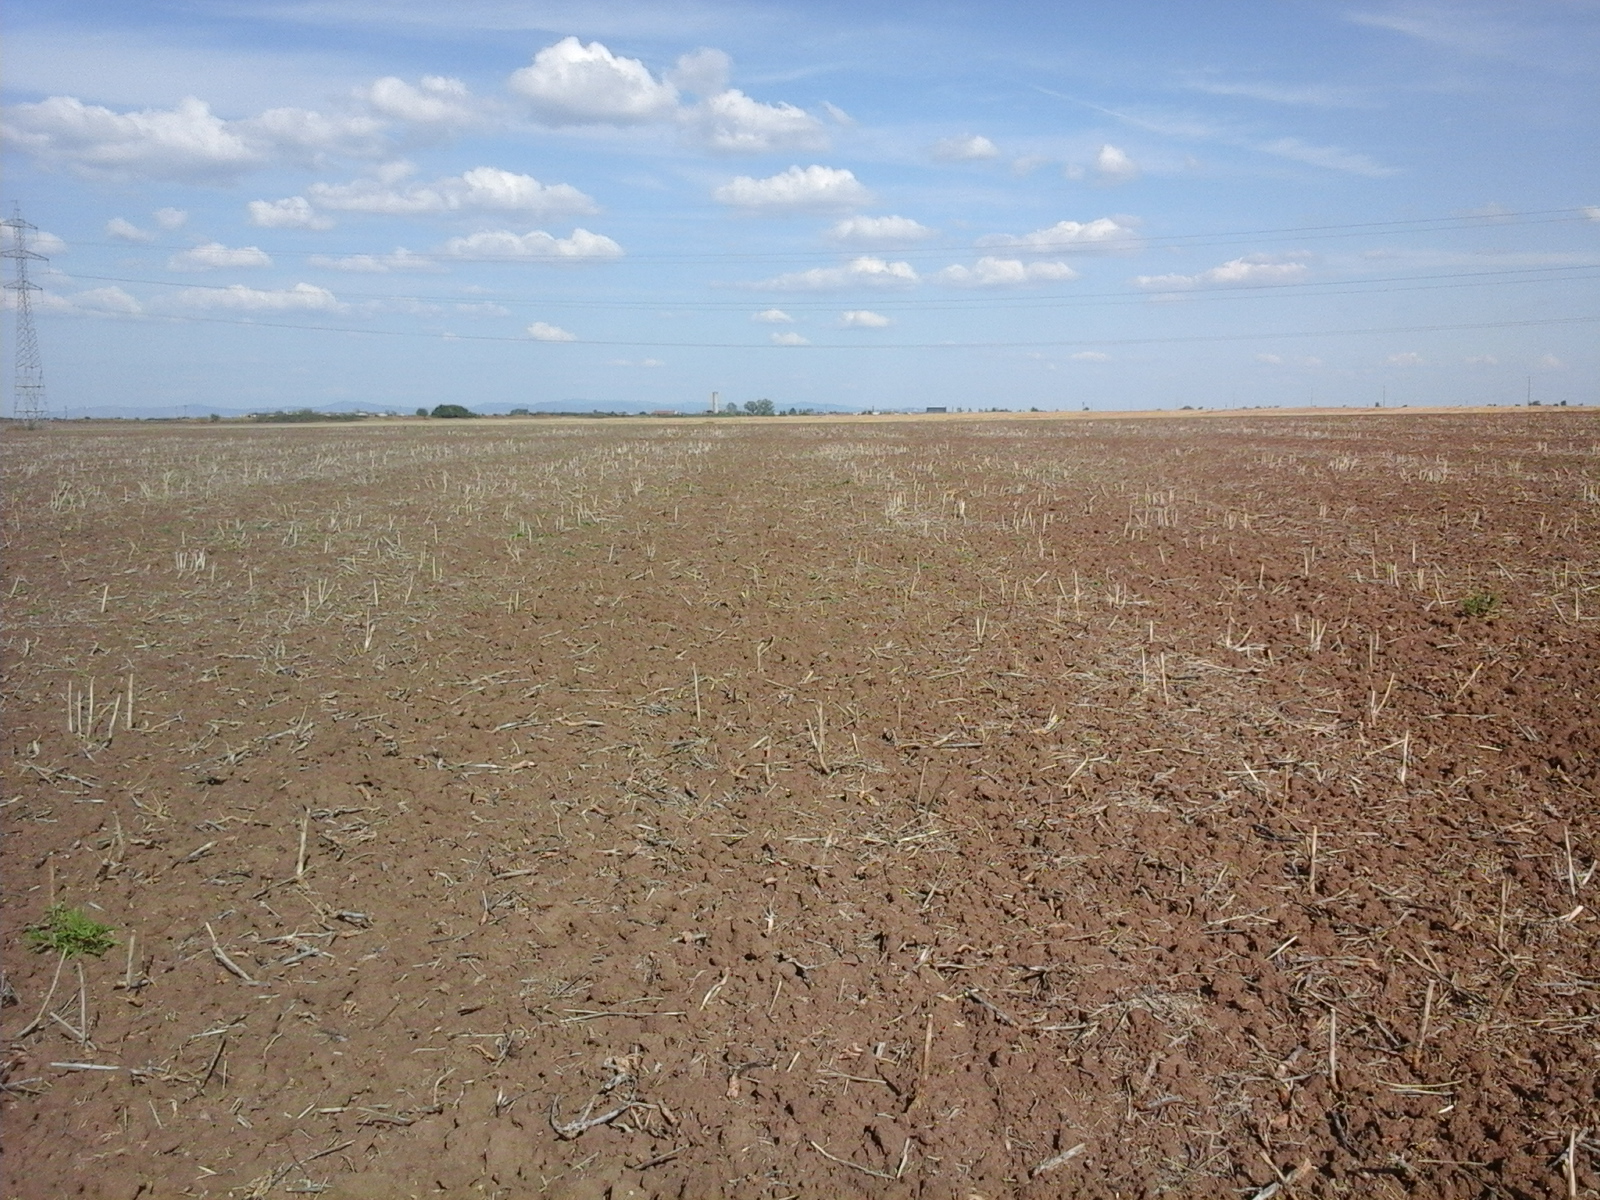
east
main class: Cropland
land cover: Rape and turnip rape
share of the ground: < 10 %
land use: Agriculture (excluding fallow land and kitchen gardens)
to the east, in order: Rape and turnip rape; Grass margins; Tracks; Grass margins; Common wheat; Electric lines; Common wheat
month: August
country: RO
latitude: 46.1163
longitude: 21.2776
